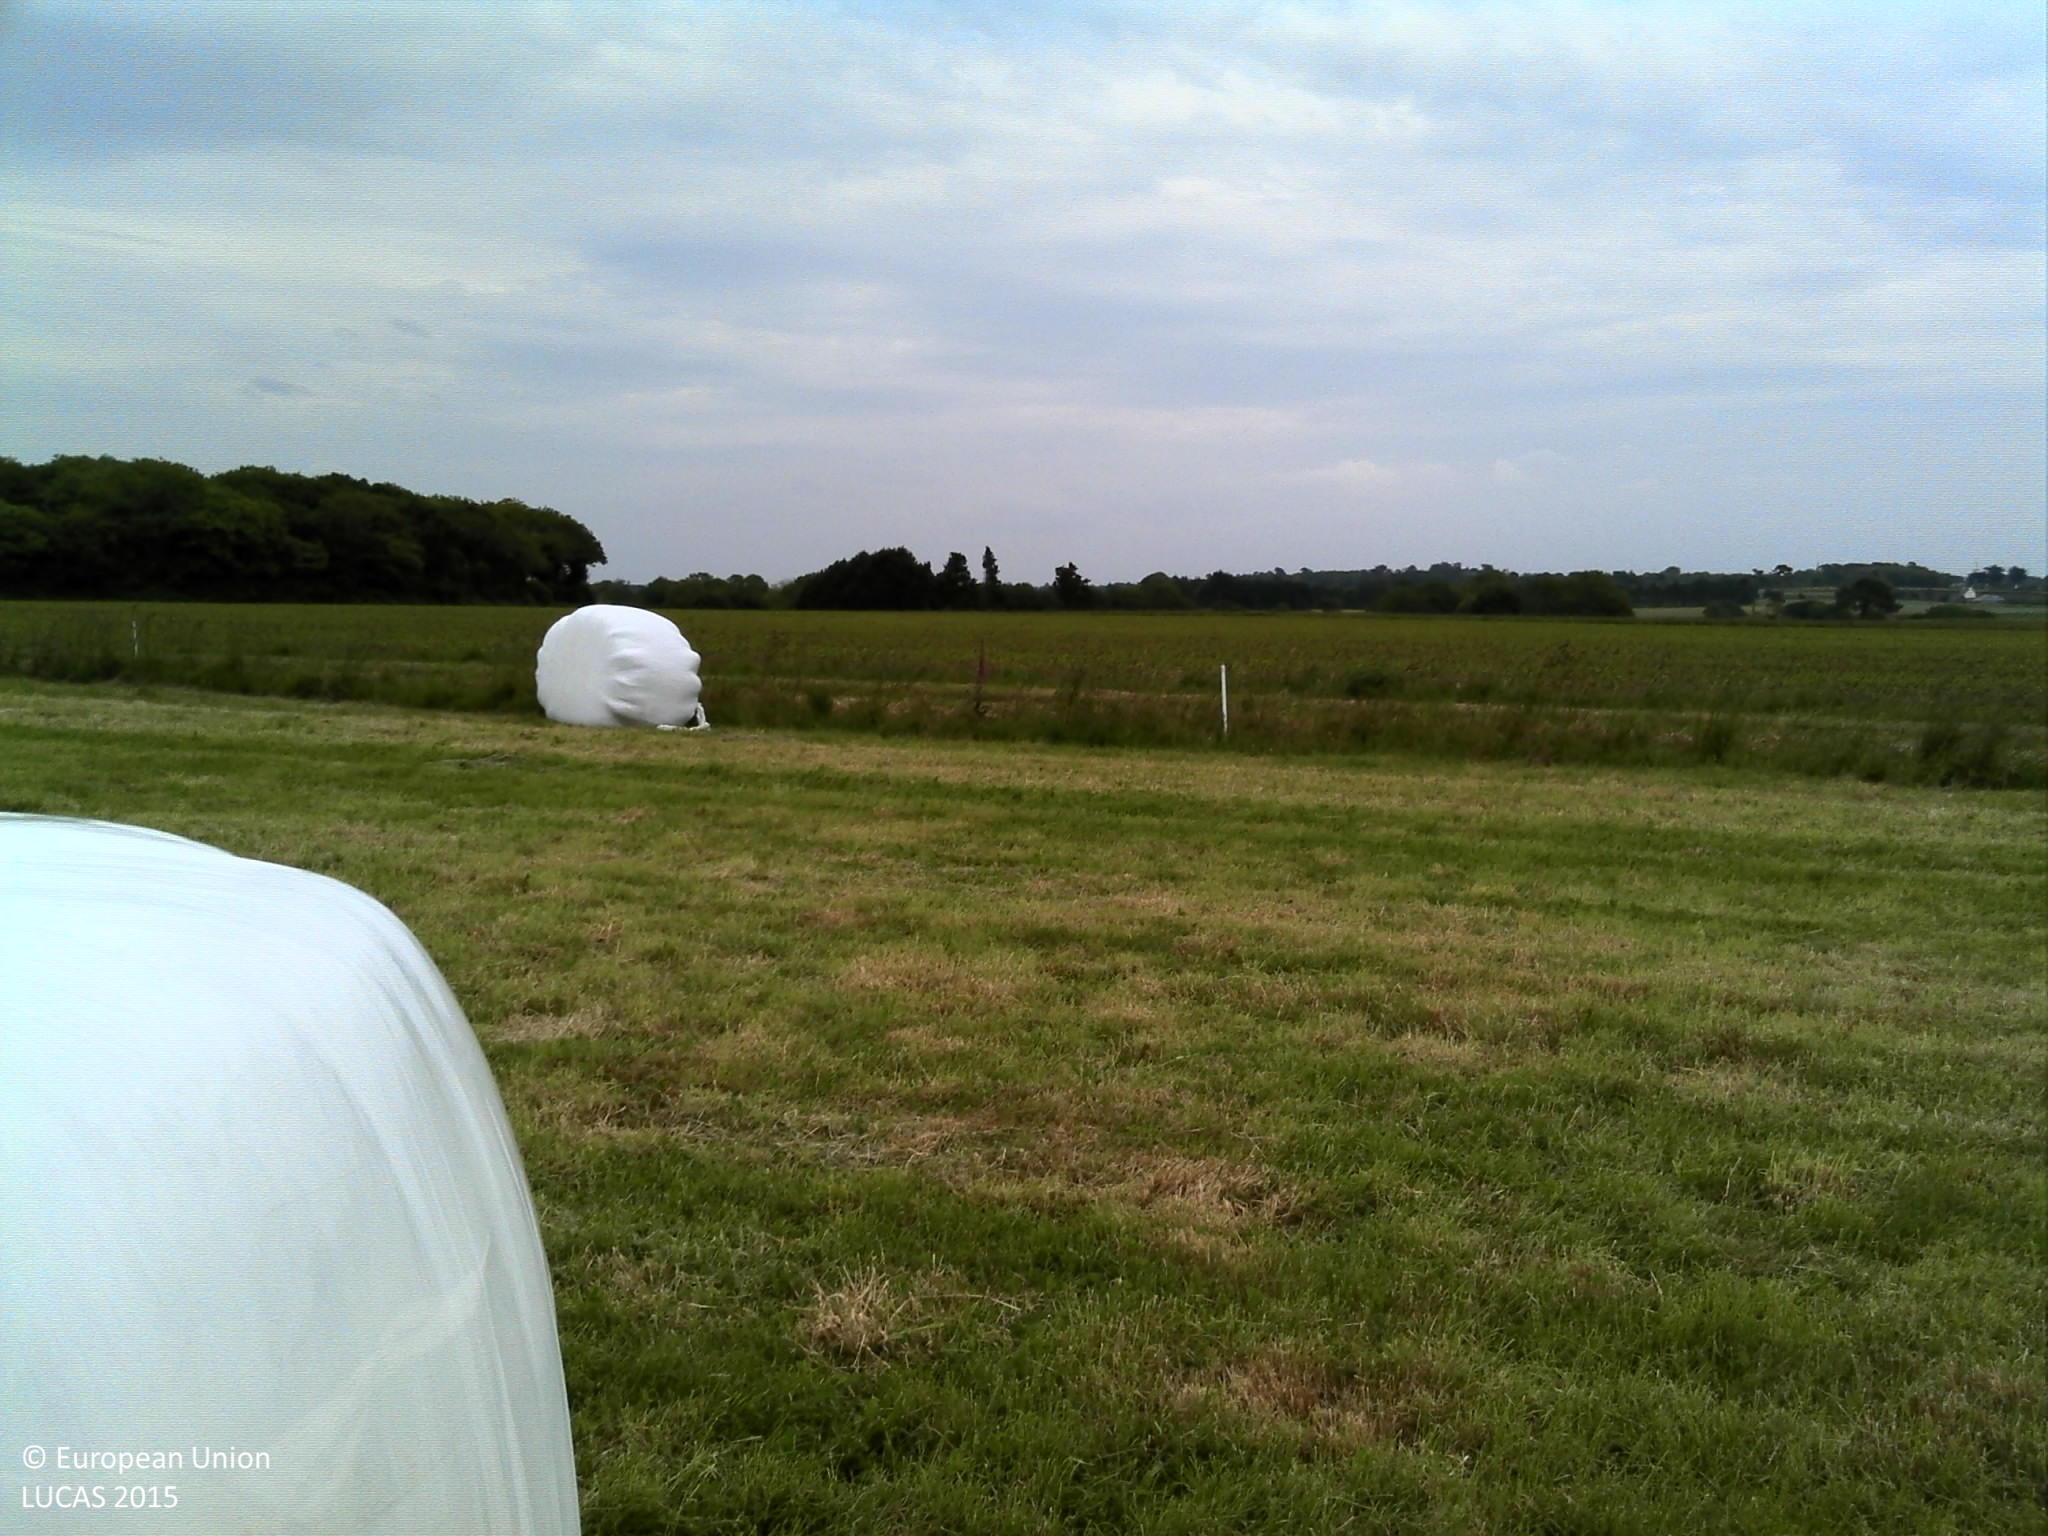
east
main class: Cropland
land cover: Temporary grasslands
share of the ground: > 75 %
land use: Agriculture (excluding fallow land and kitchen gardens)
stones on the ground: < 10 %
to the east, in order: Temporary grasslands; Fences; Grass margins; Tracks; Maize; Grass margins; Tracks; Grass margins; Common wheat
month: June
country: FR
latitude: 48.0069
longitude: -4.3694
